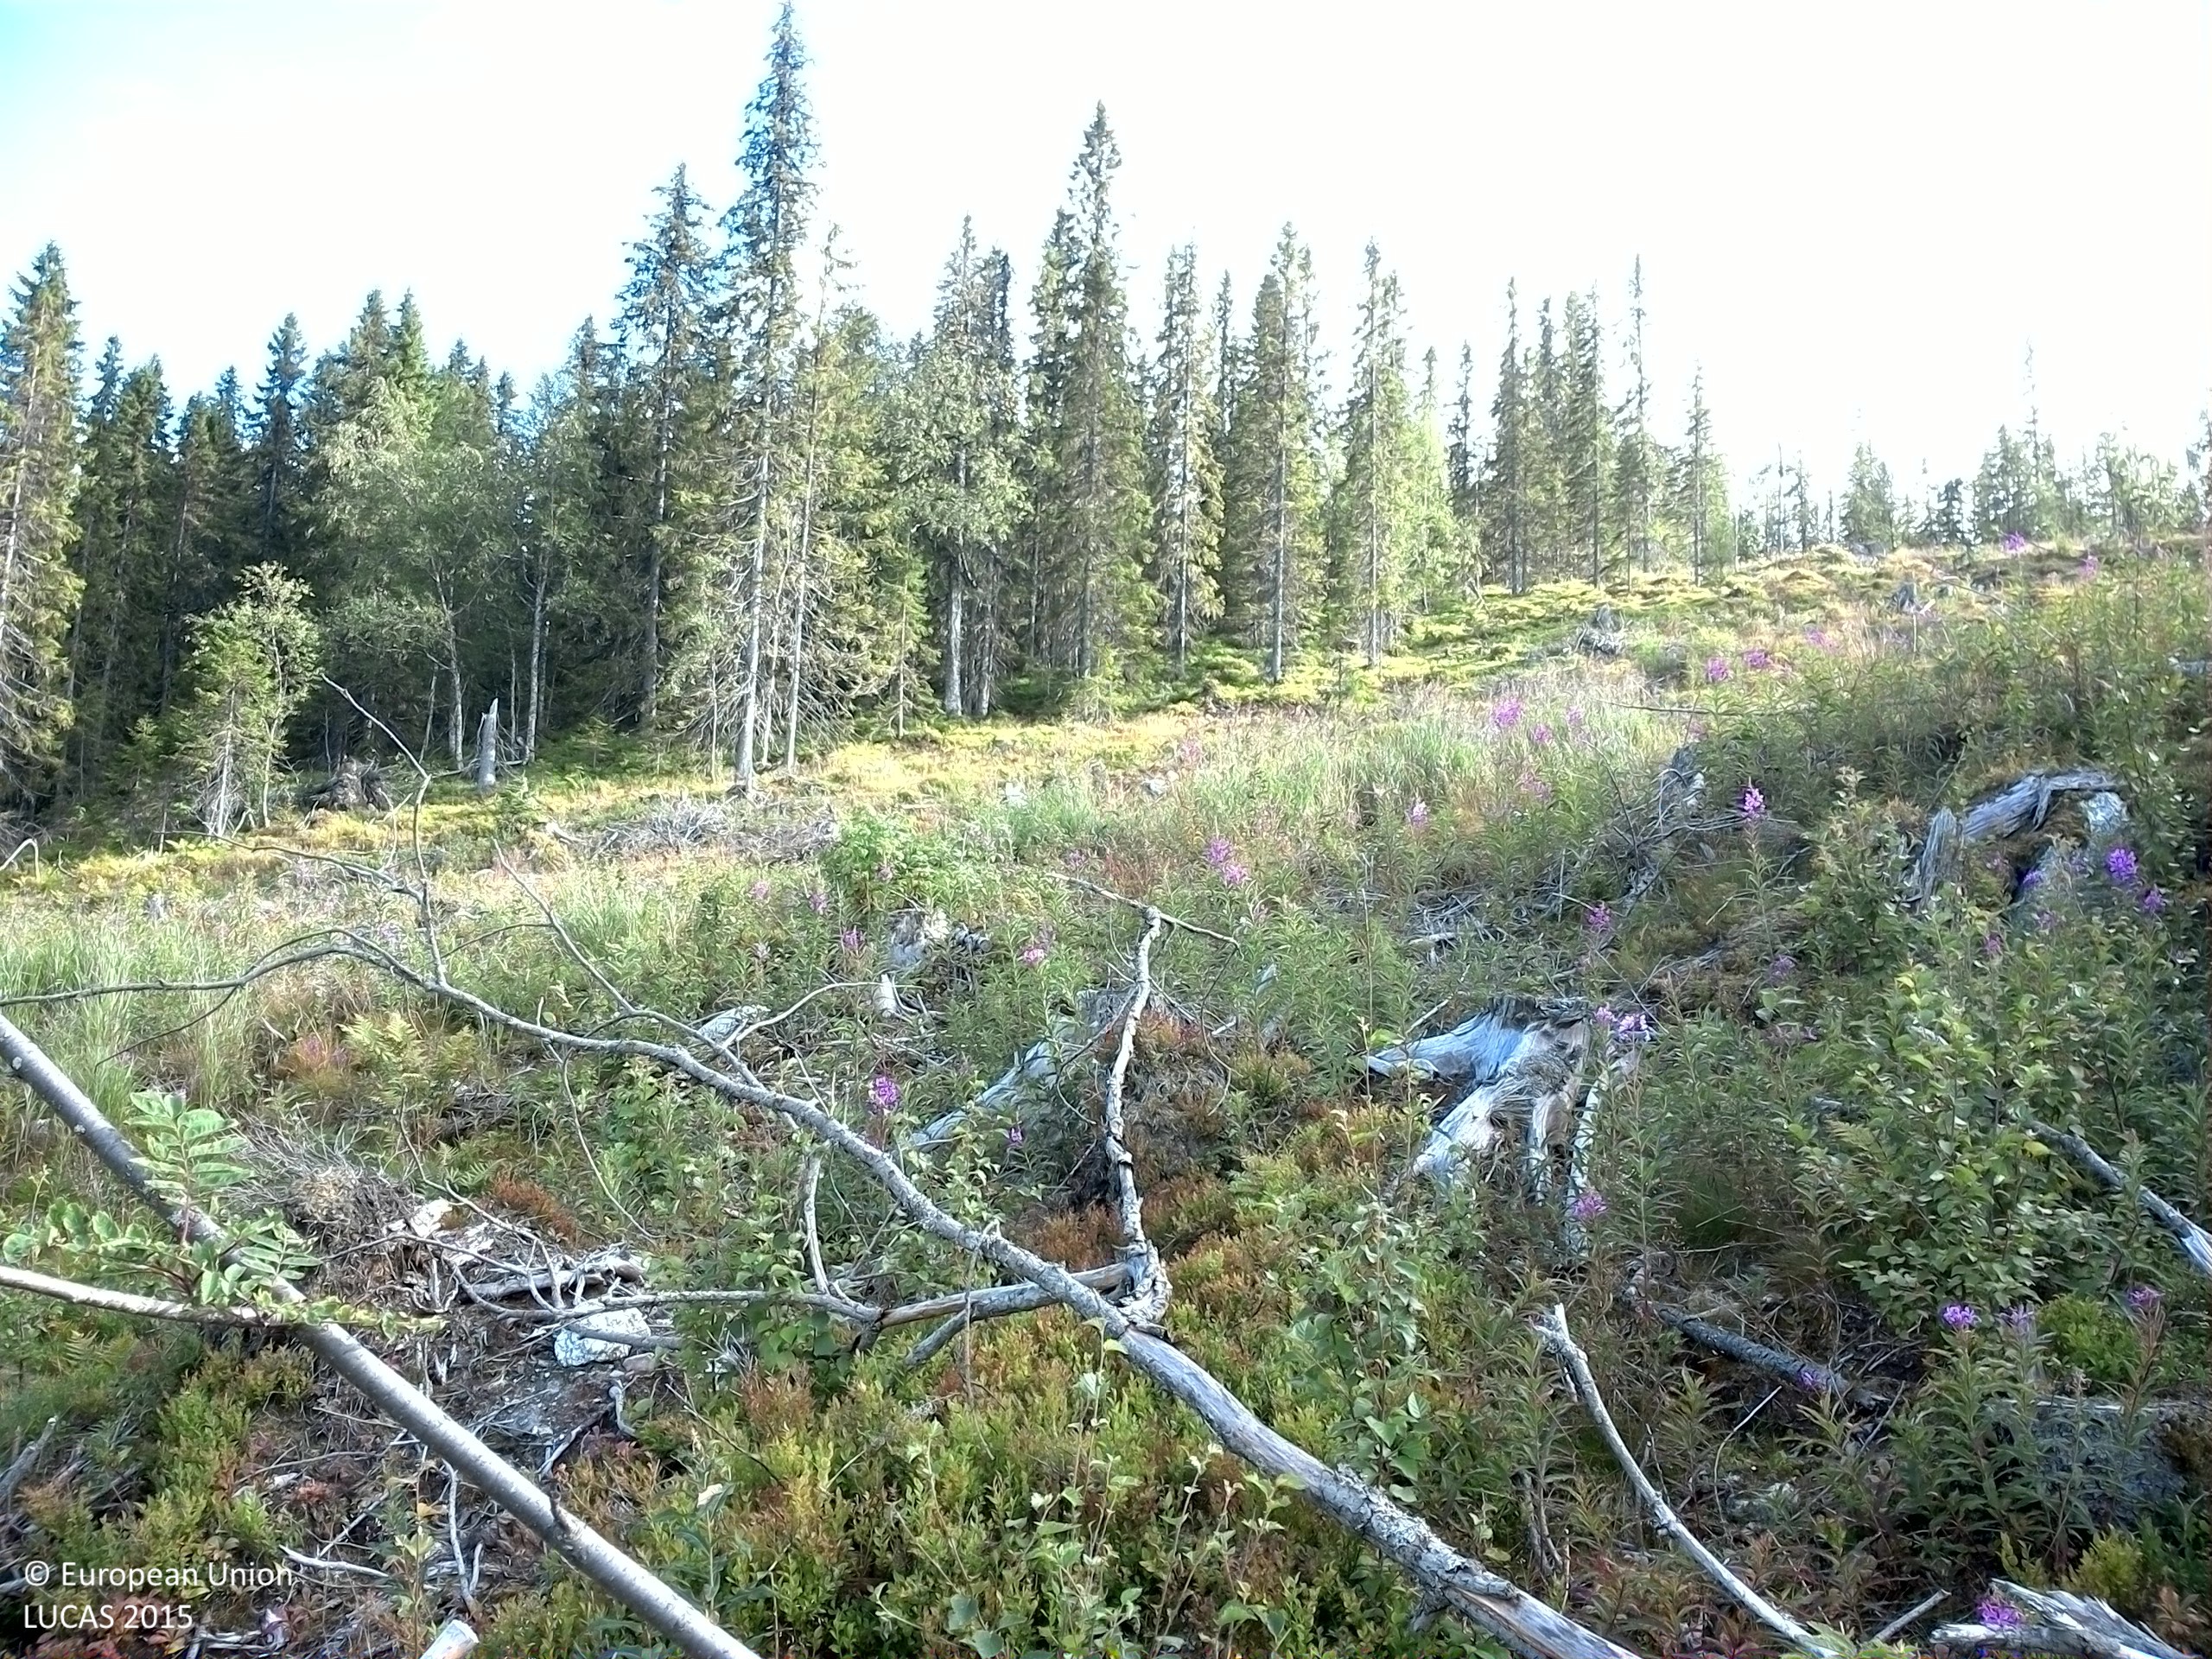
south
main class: Woodland
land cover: Broadleaved woodland
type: boreal forest
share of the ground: 10 - 25 %
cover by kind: herbaceous plants 55 %, shrubs 30 %, broadleaved forest trees 10 %, lichens and mosses 5 %
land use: Forestry
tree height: < 5 m
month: August
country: SE
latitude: 63.8151
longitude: 17.9957
